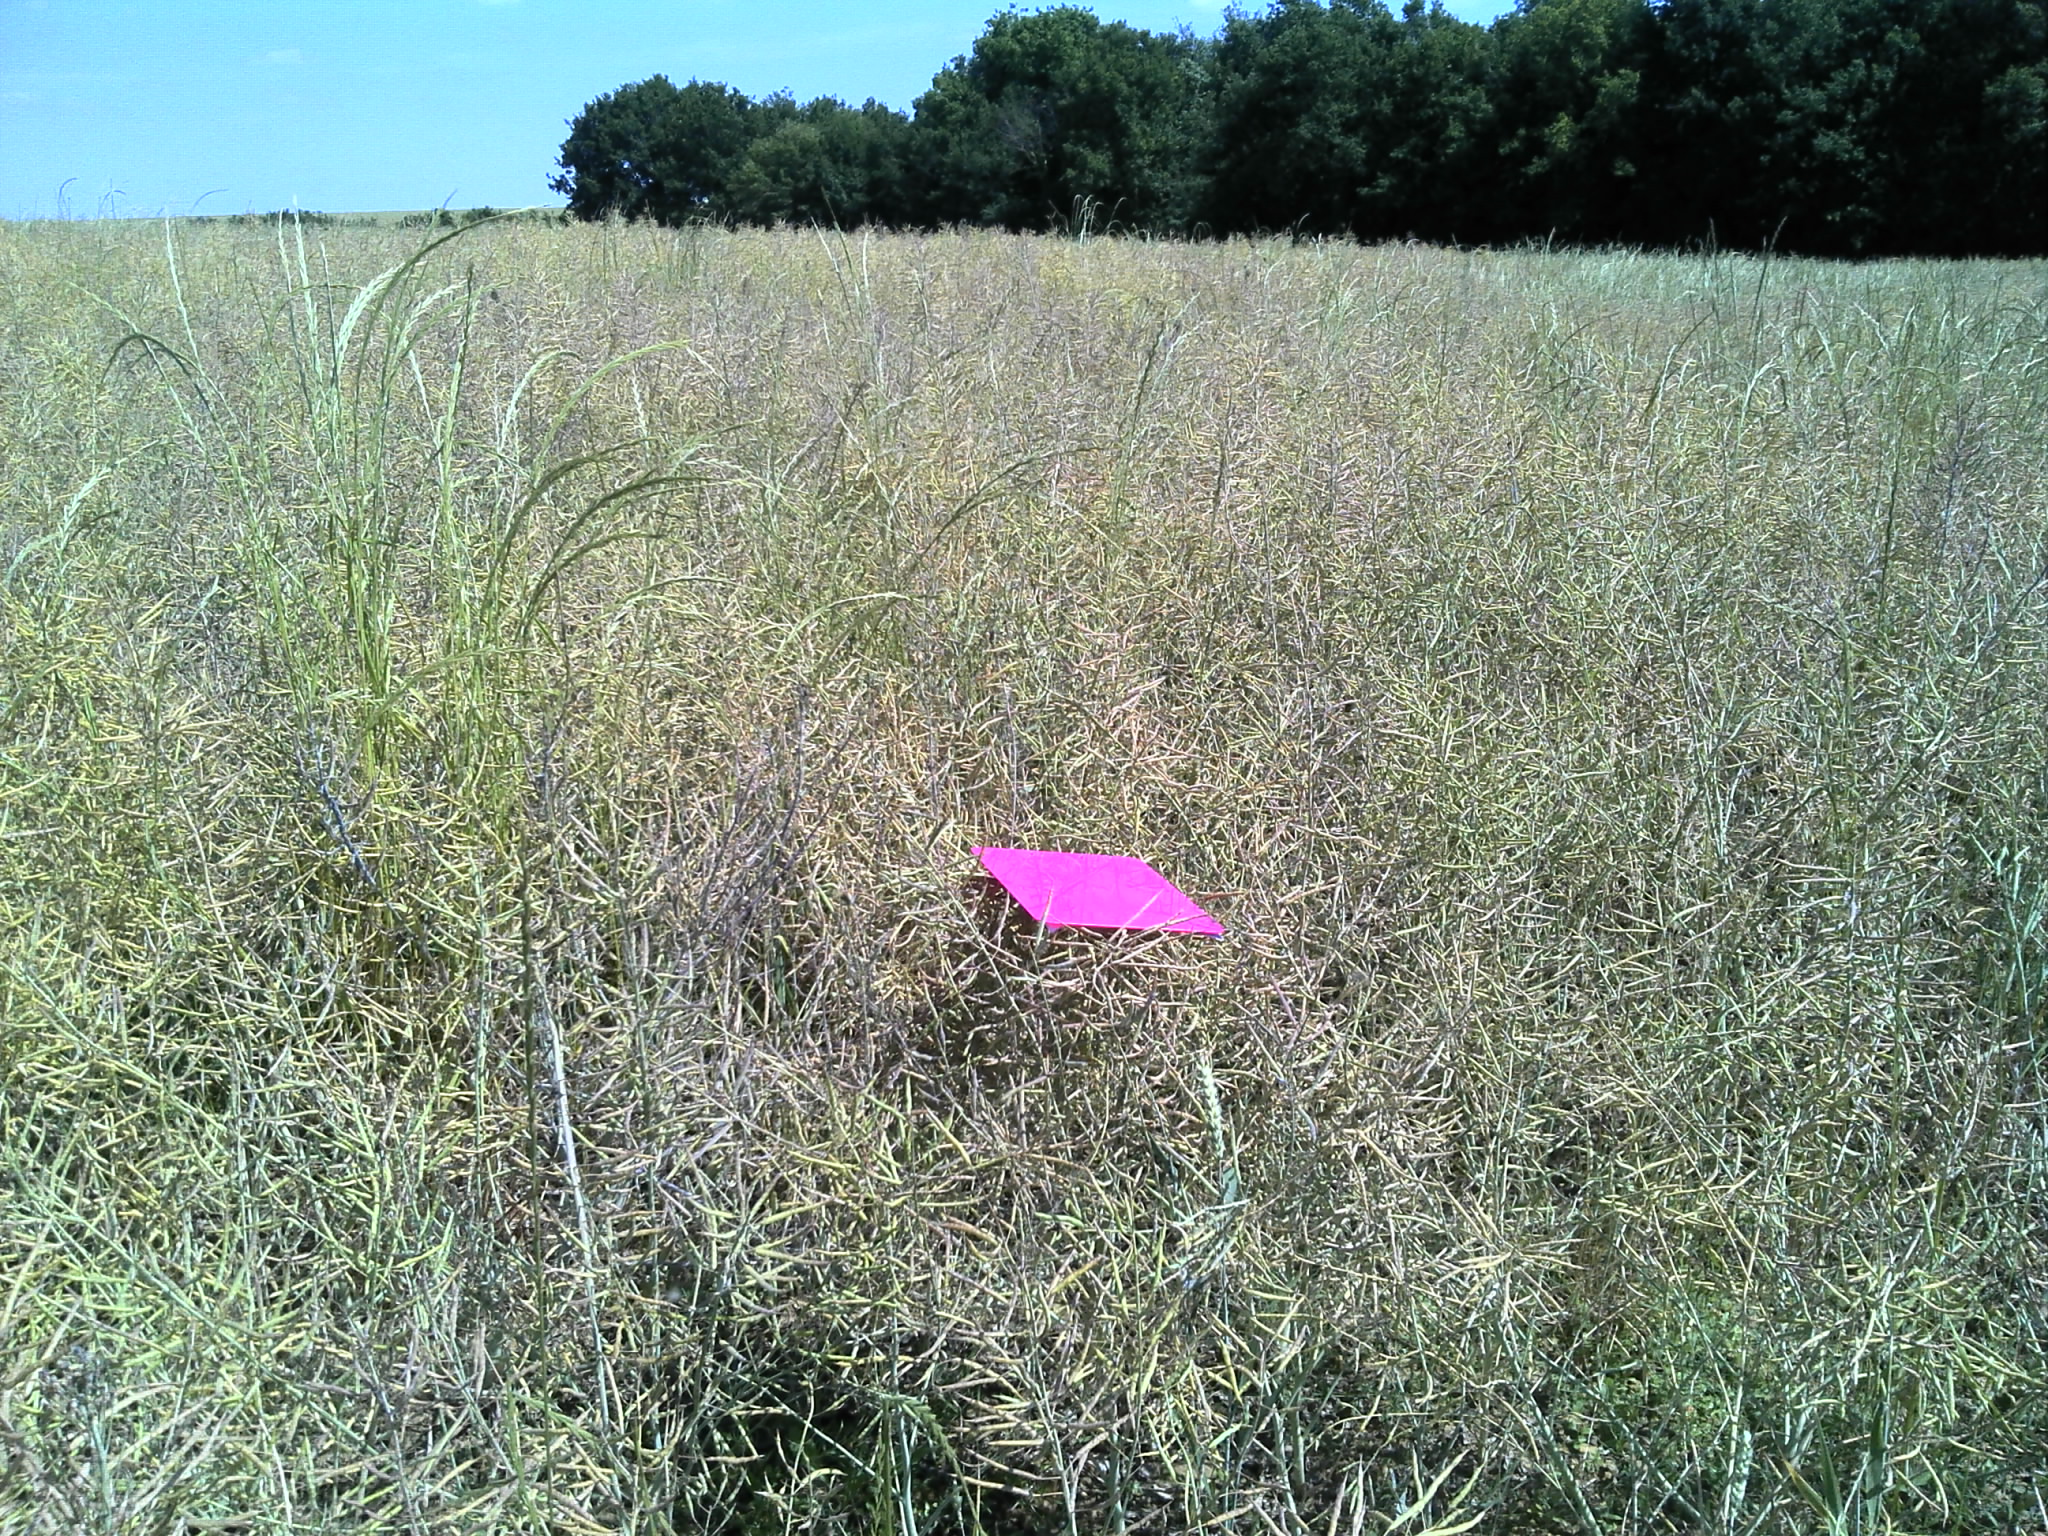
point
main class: Cropland
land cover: Rape and turnip rape
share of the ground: > 75 %
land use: Agriculture (excluding fallow land and kitchen gardens)
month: June
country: FR
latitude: 47.1493
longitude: 1.4545
